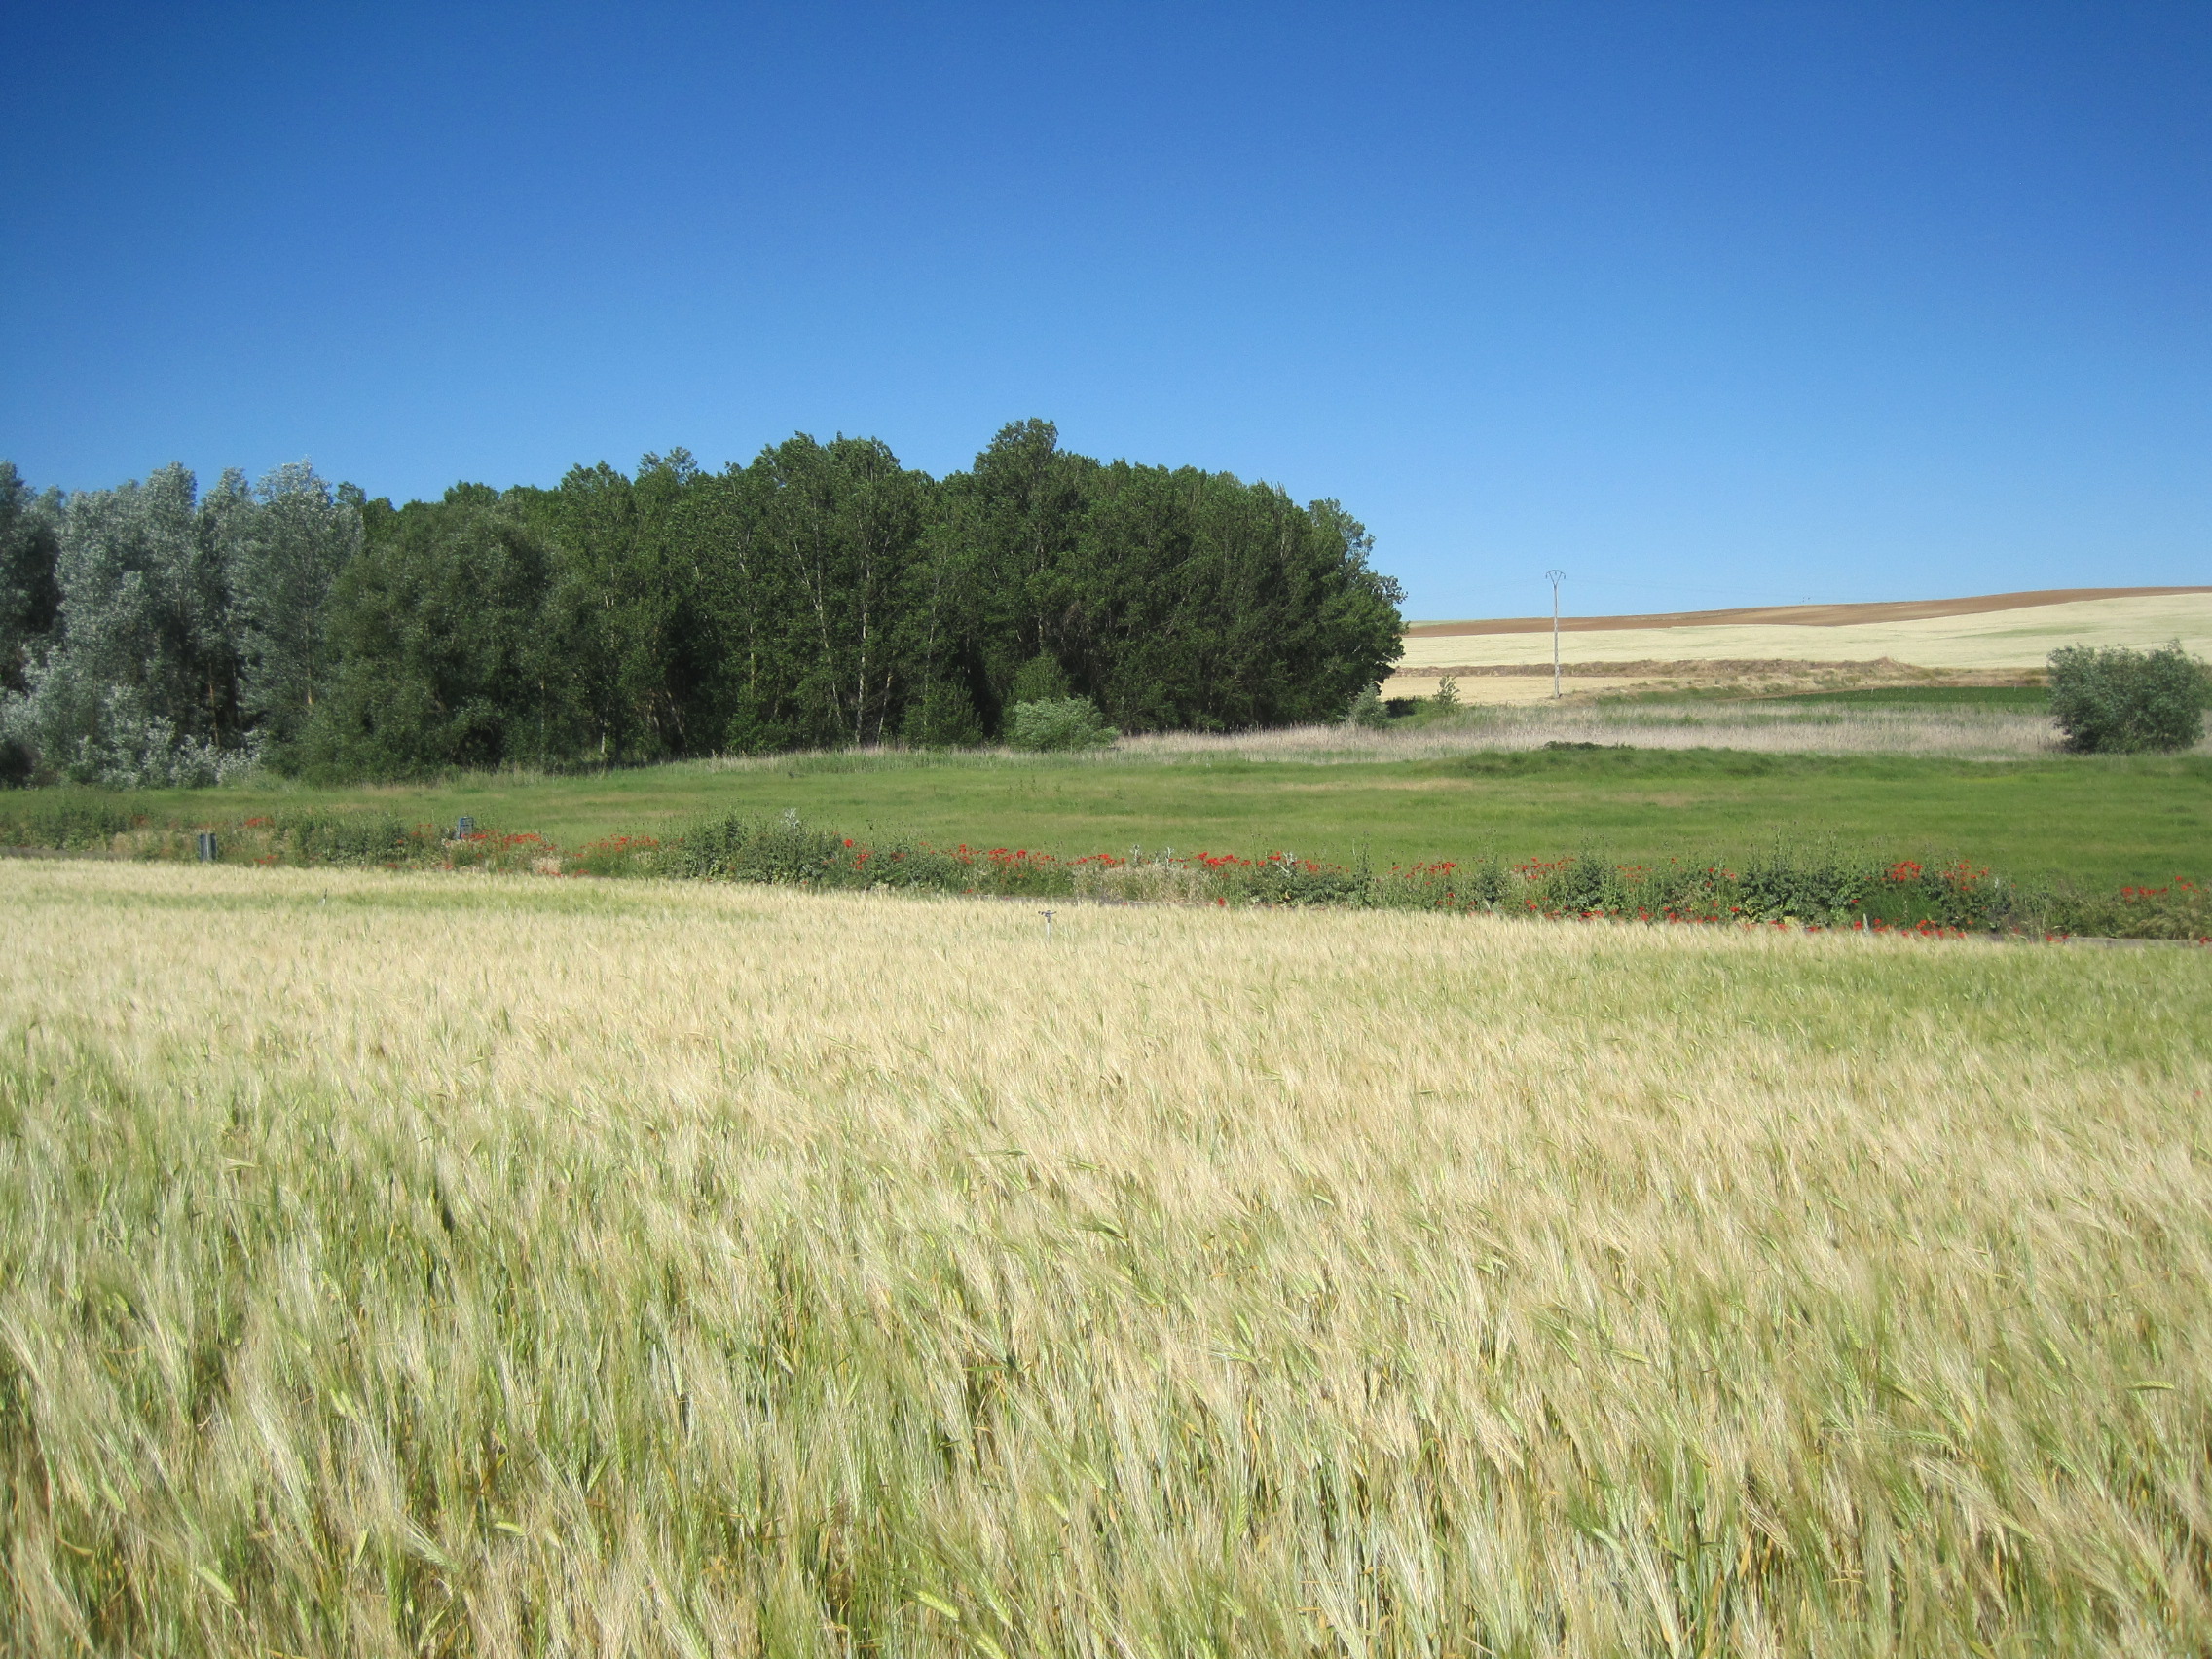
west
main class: Cropland
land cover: Common wheat
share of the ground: > 75 %
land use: Agriculture (excluding fallow land and kitchen gardens)
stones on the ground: < 10 %
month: May
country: ES
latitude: 41.1512
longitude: -5.3134
